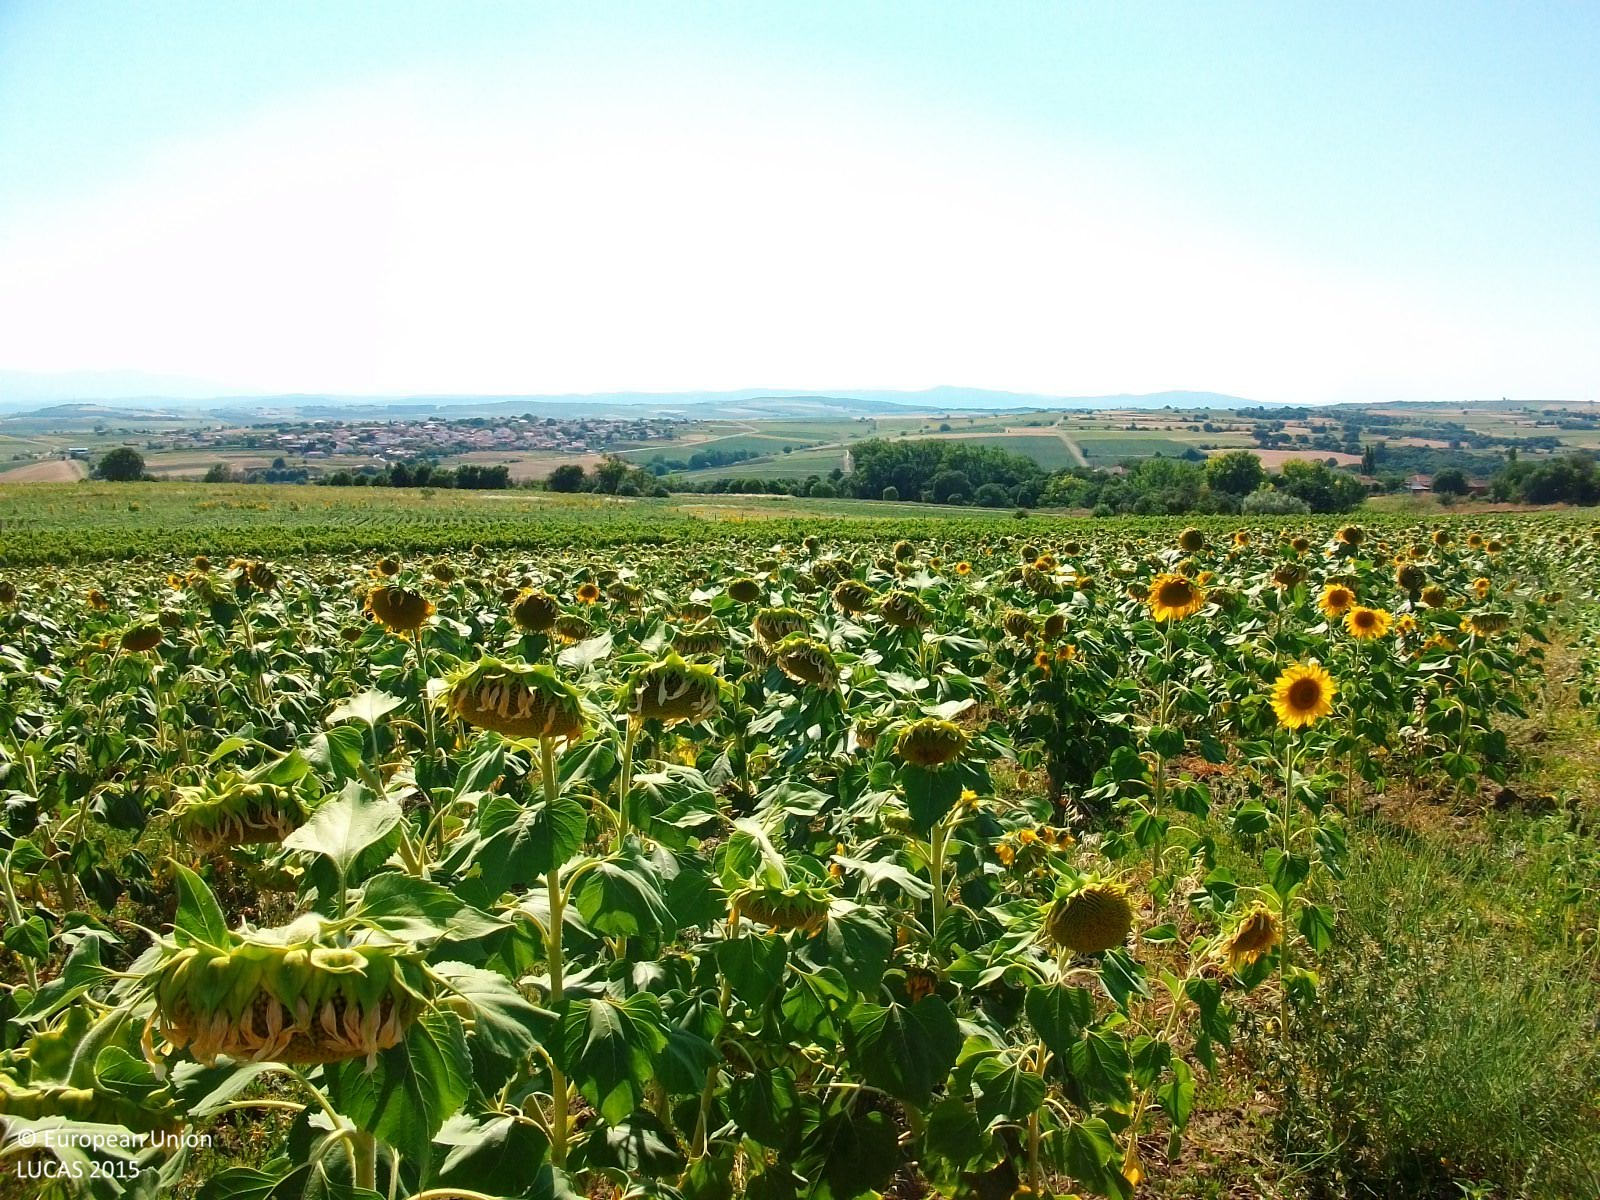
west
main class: Cropland
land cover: Sunflower
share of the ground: > 75 %
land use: Agriculture (excluding fallow land and kitchen gardens)
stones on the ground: < 10 %
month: July
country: GR
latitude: 41.4882
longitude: 26.3034
